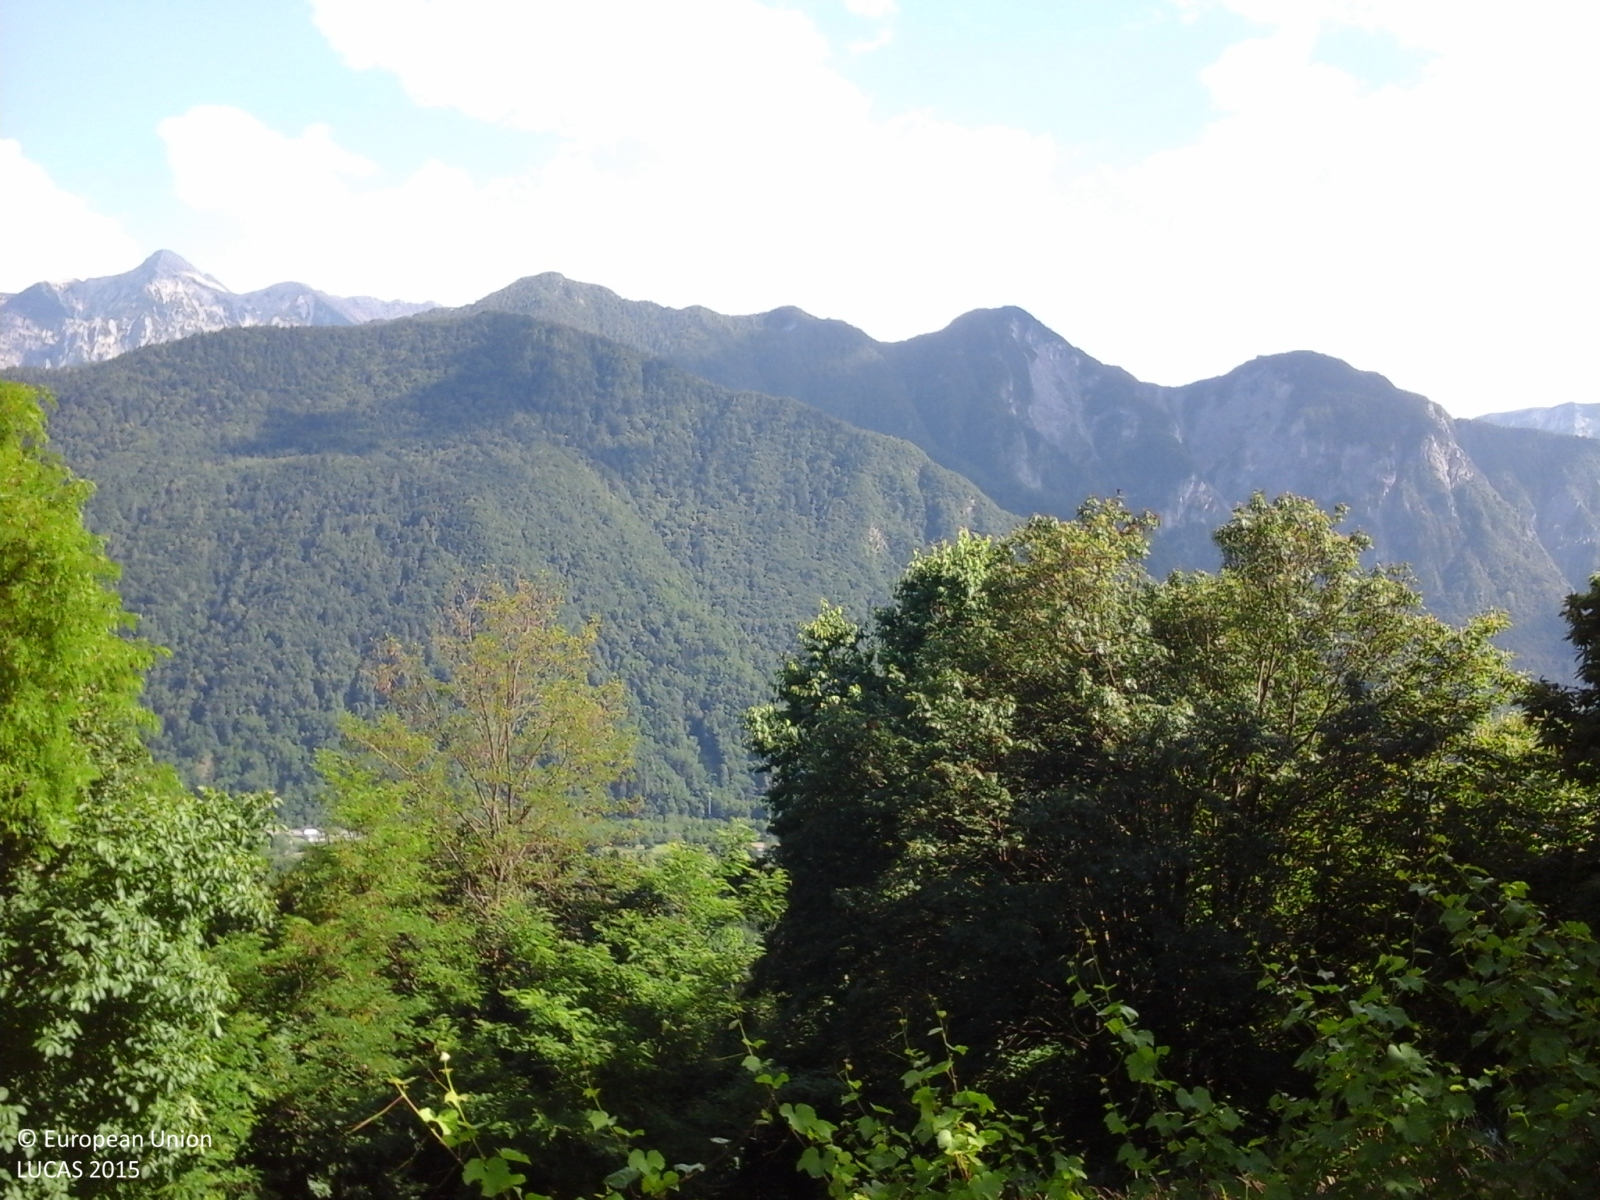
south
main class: Grassland
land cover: Grassland without tree/shrub cover
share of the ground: > 75 %
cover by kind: herbaceous plants 100 %
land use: Agriculture (excluding fallow land and kitchen gardens)
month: June
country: IT
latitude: 46.0537
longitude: 11.4068
